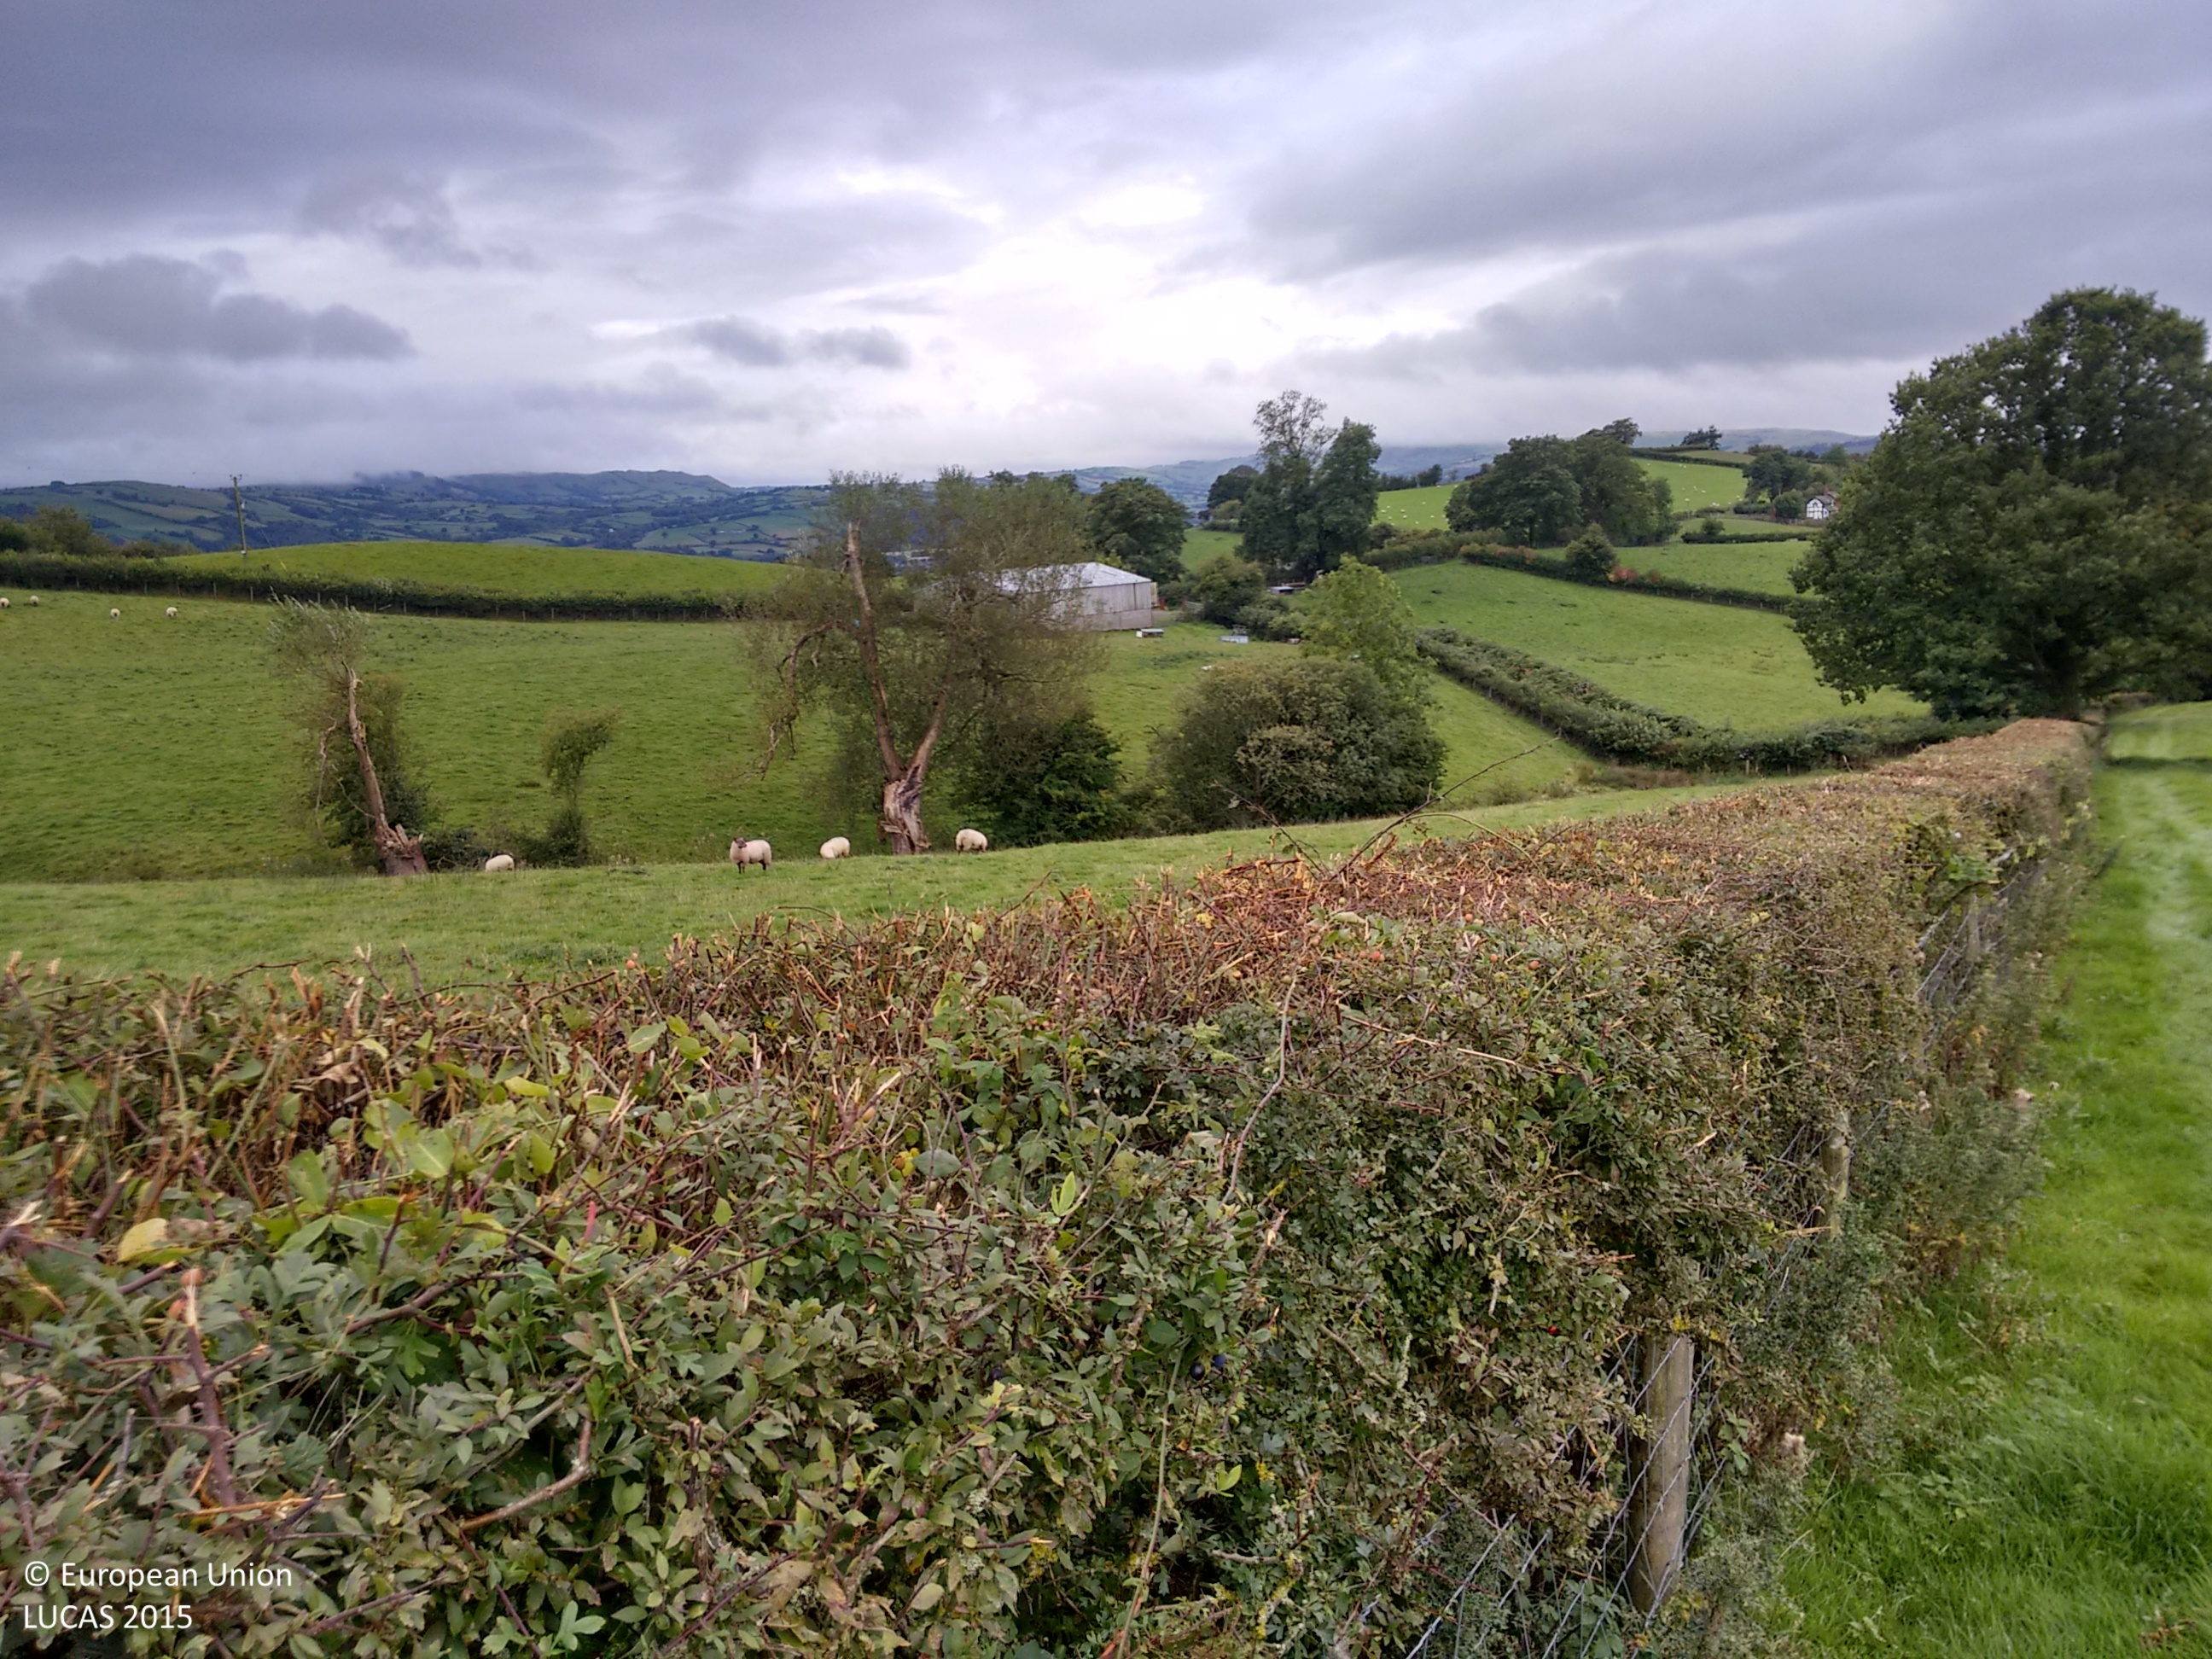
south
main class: Grassland
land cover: Grassland with sparse tree/shrub cover
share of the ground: > 75 %
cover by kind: herbaceous plants 95 %, broadleaved forest trees 5 %
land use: Agriculture (excluding fallow land and kitchen gardens)
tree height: > 5 m
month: September
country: GB
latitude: 52.5358
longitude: -3.3049
